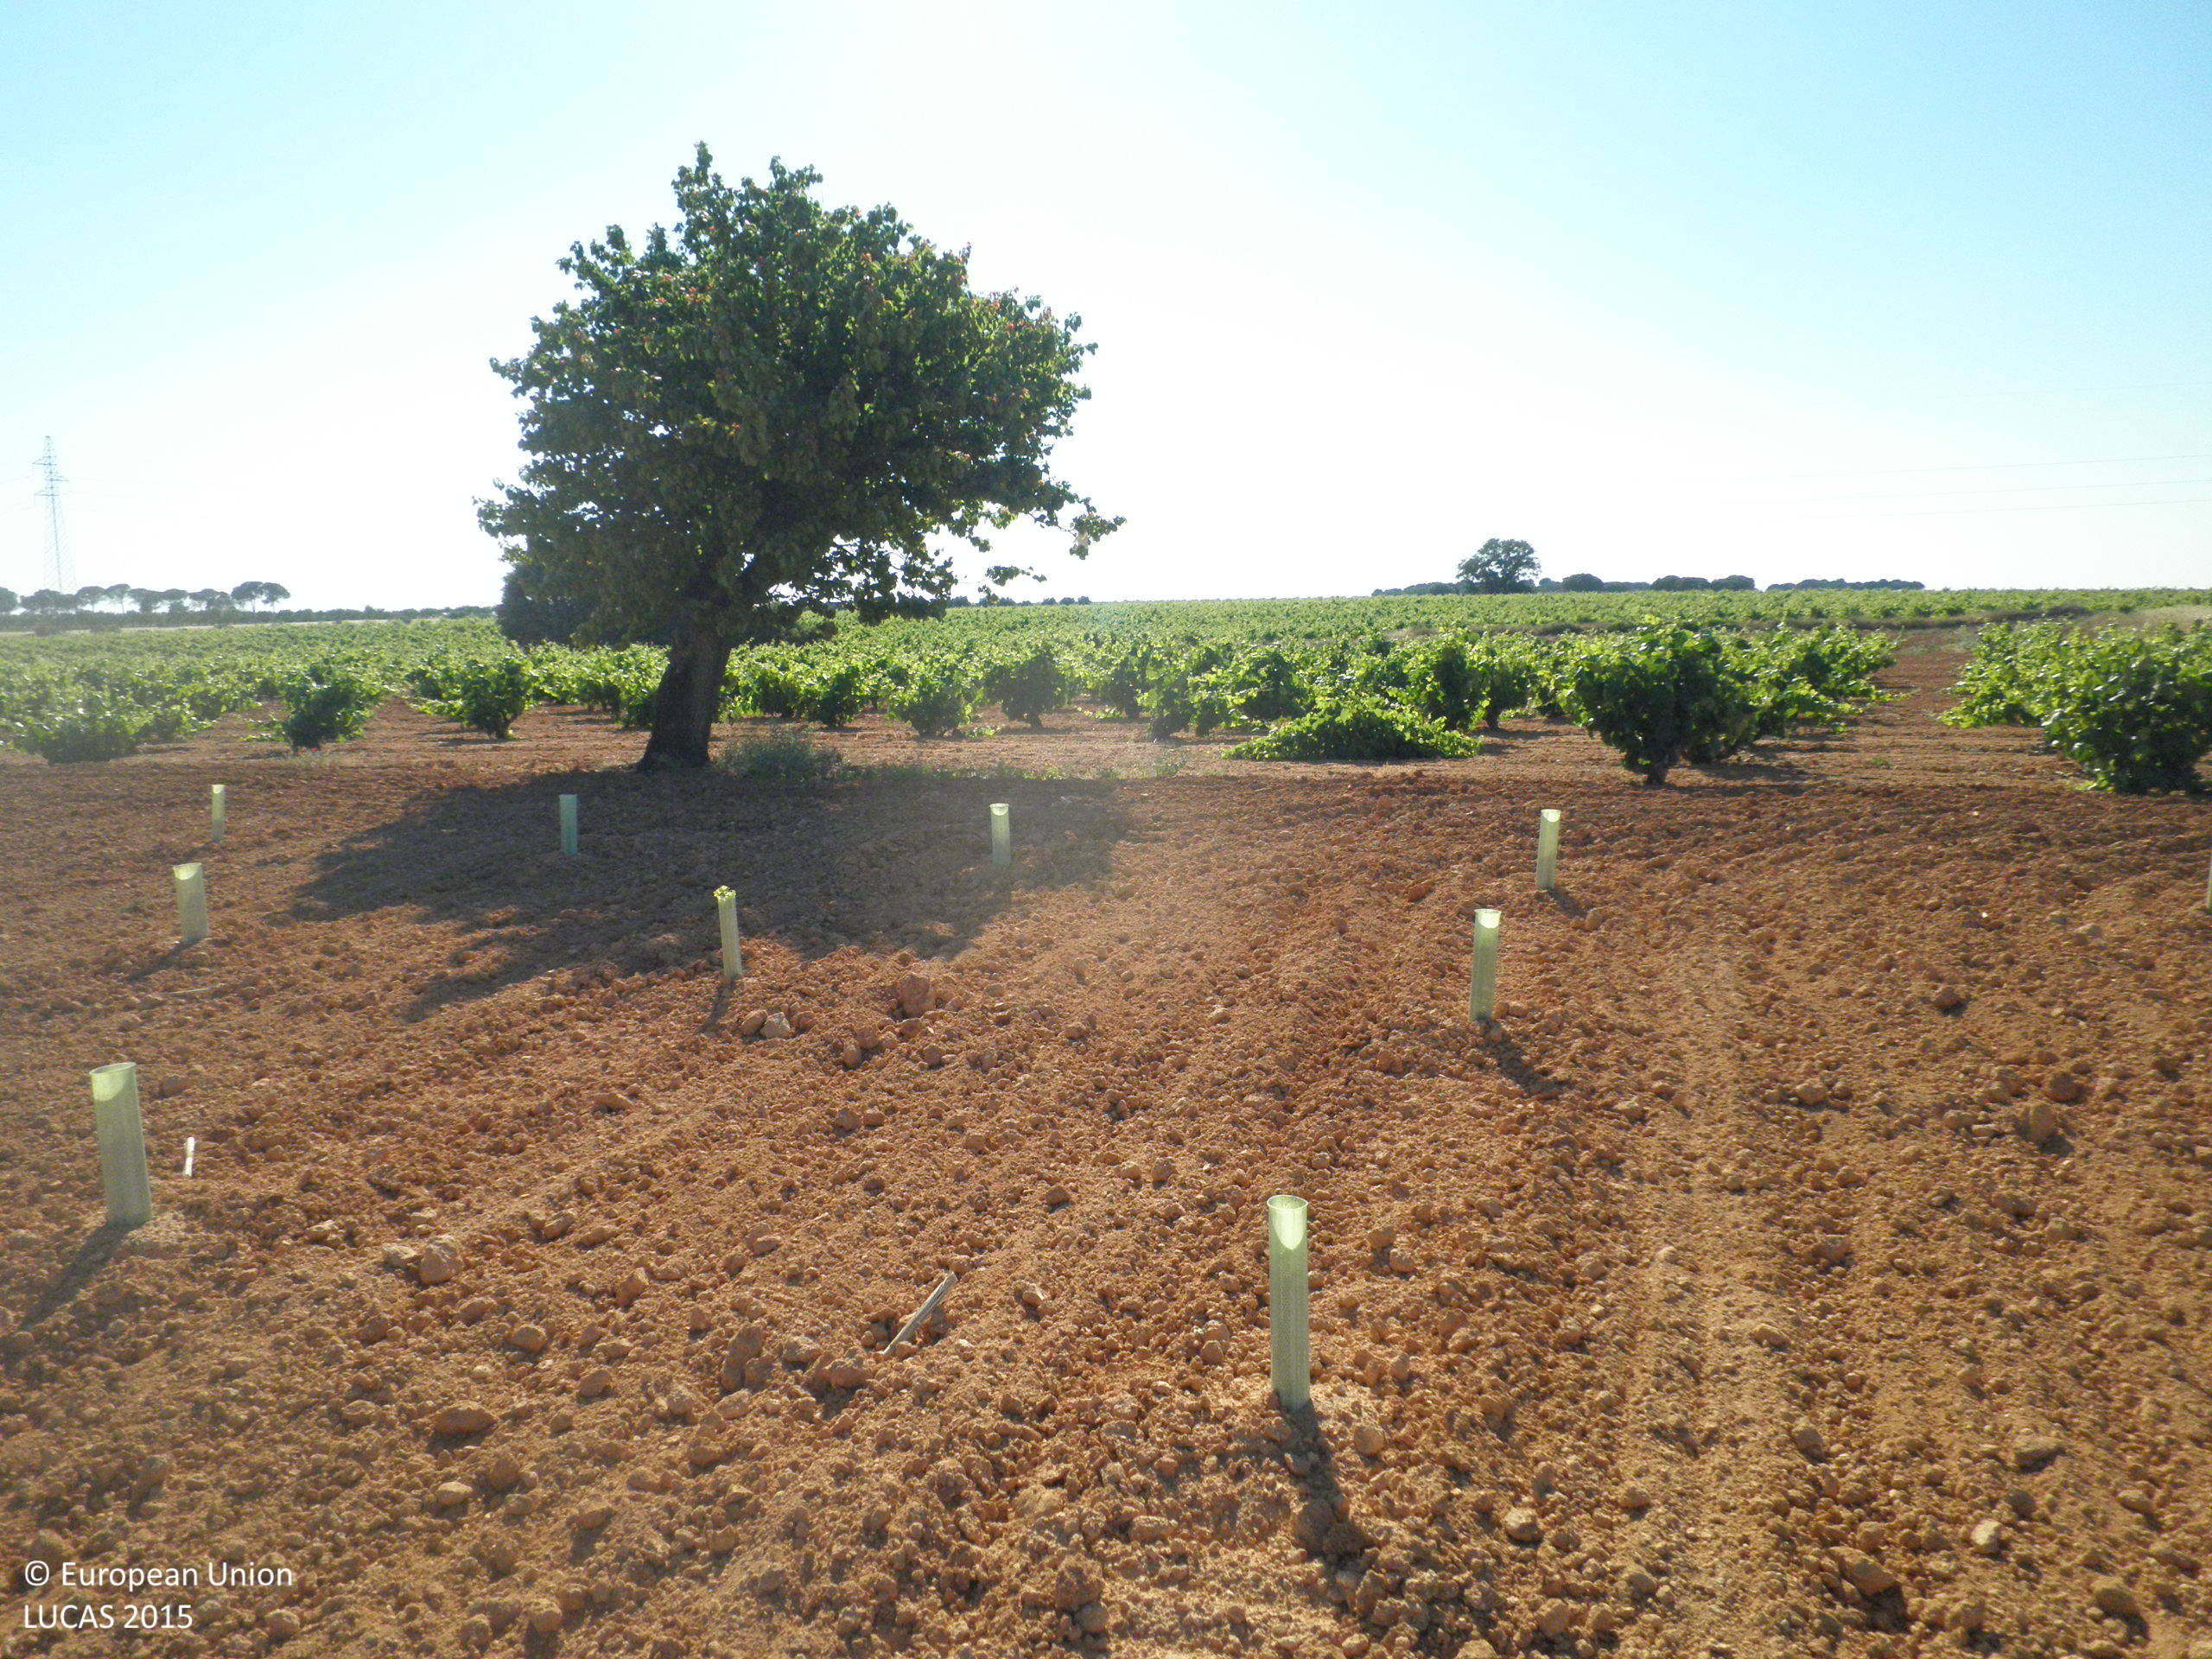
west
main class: Cropland
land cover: Vineyards
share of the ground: < 10 %
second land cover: Other bare soil
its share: > 75 %
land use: Agriculture (excluding fallow land and kitchen gardens)
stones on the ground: < 10 %
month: June
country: ES
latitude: 39.4033
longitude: -1.6751
